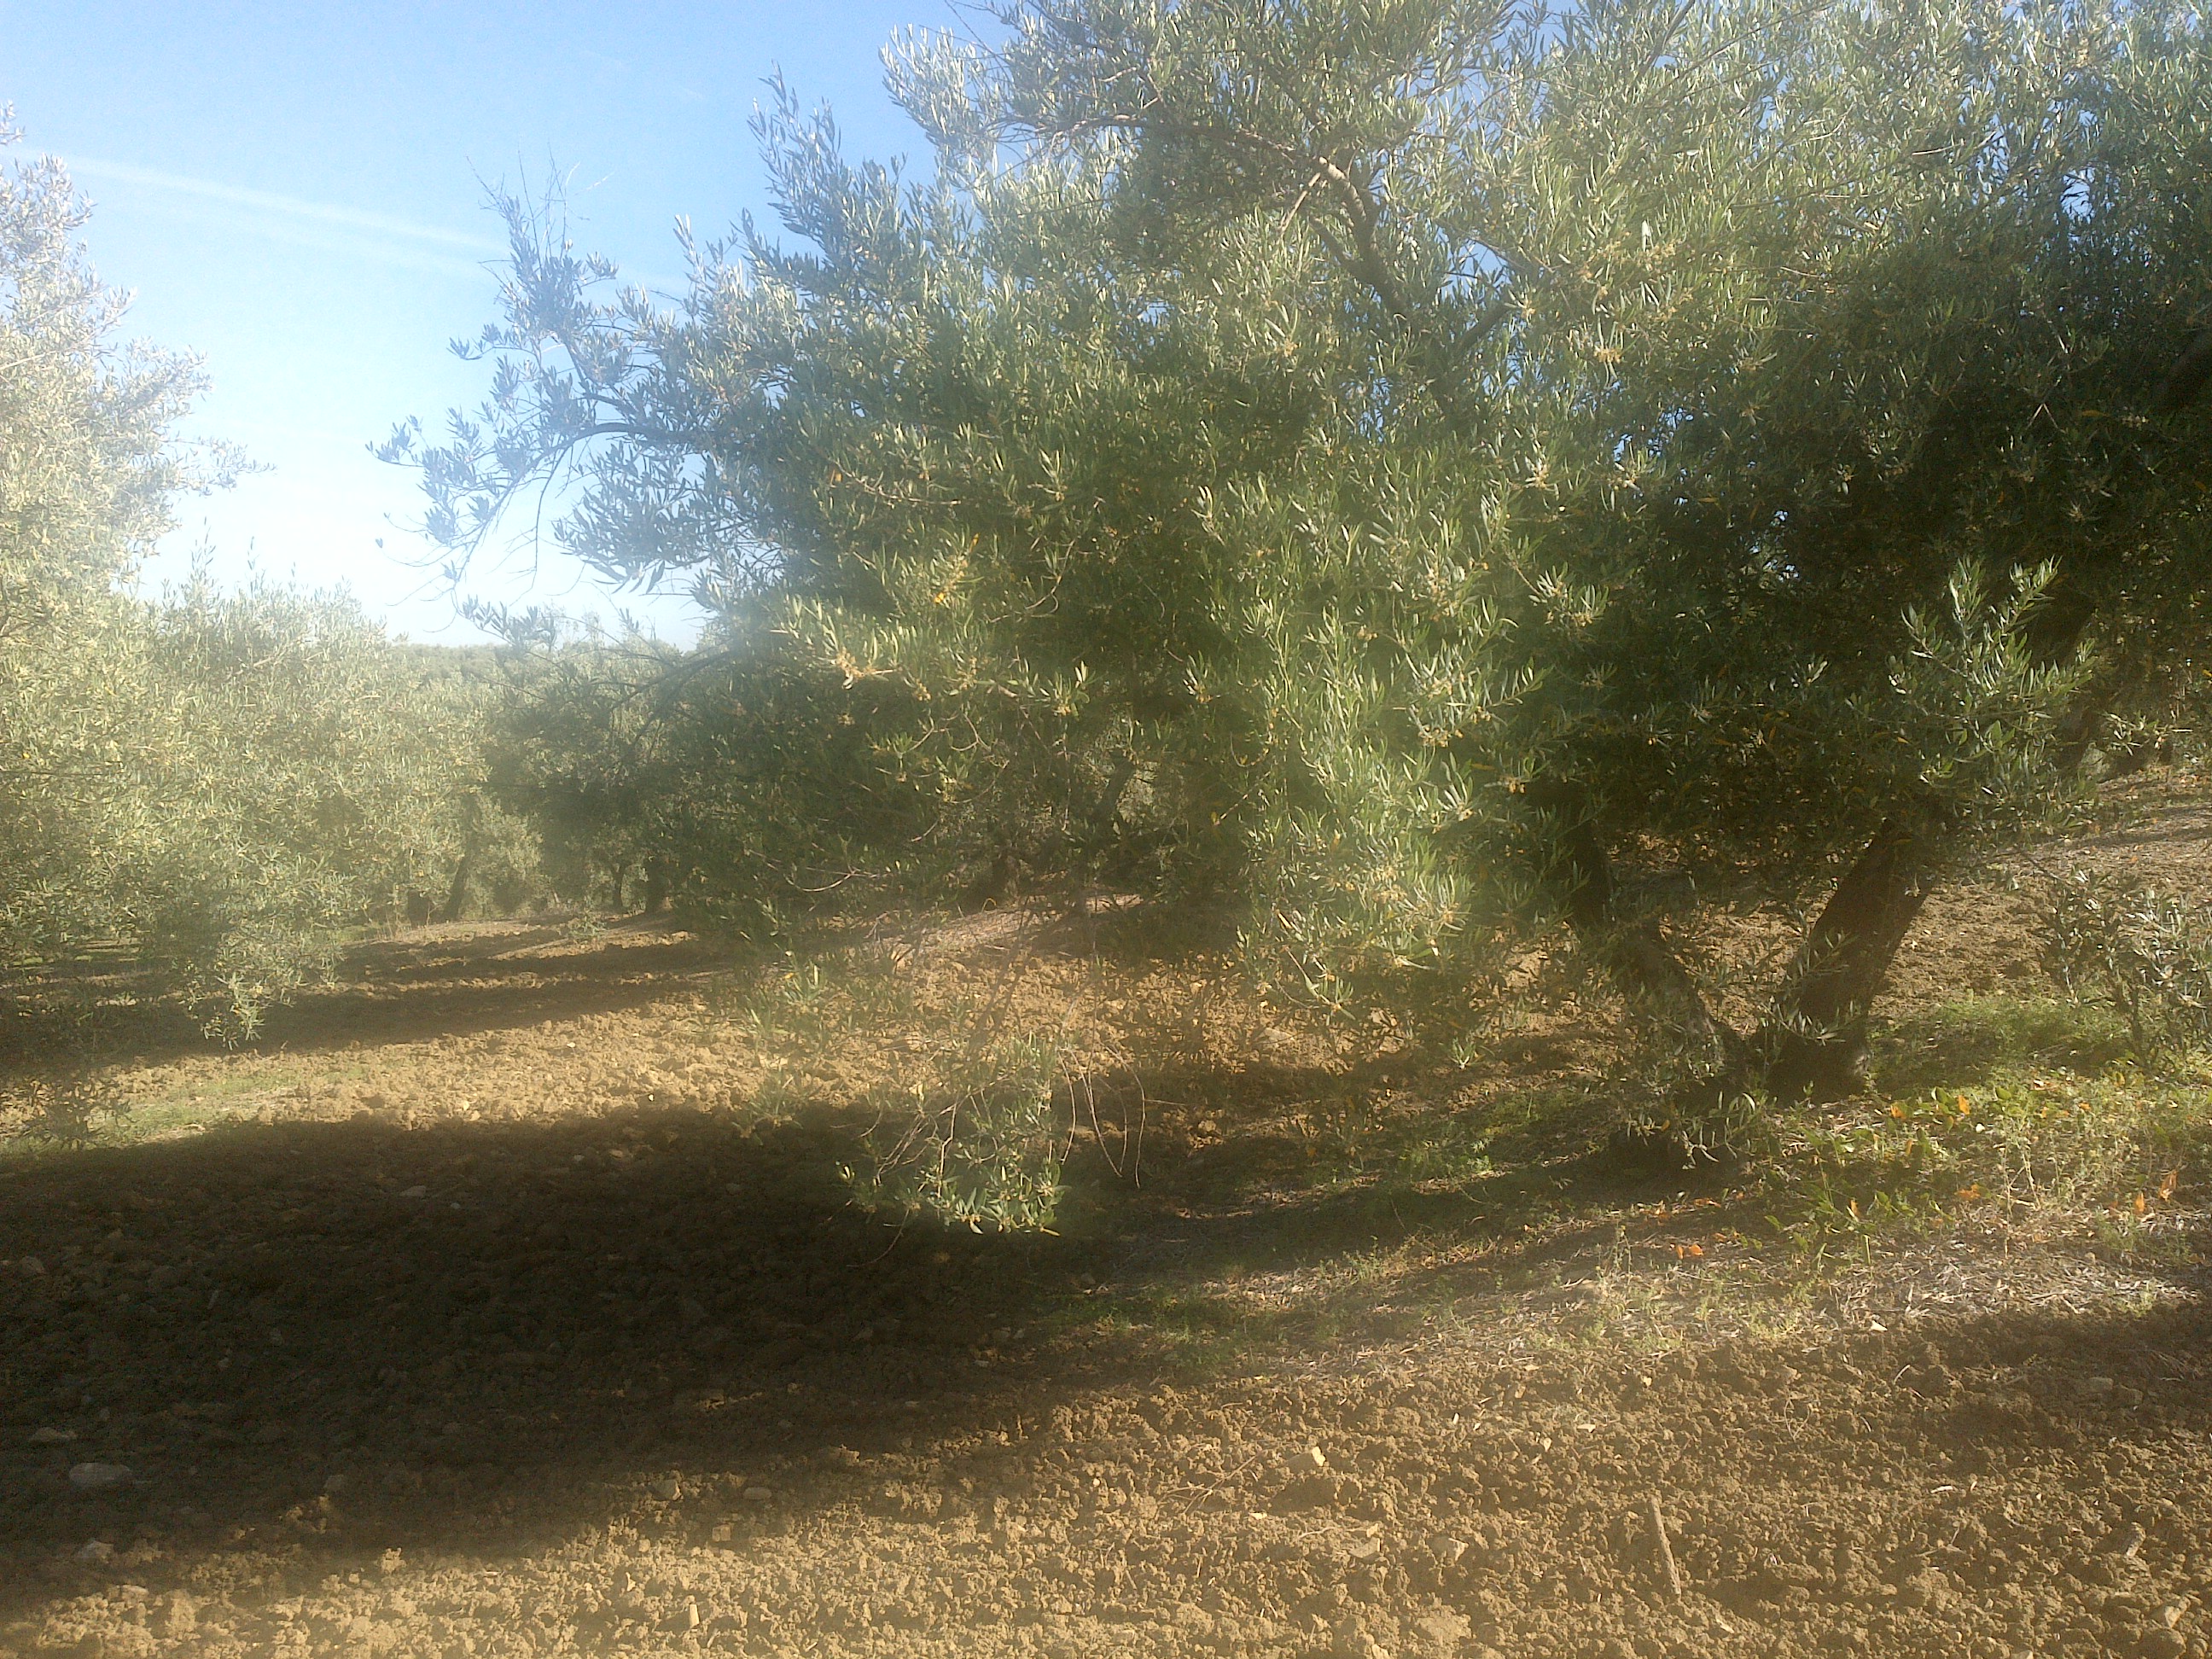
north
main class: Cropland
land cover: Olive groves
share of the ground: 50 - 75 %
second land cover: Other bare soil
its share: > 75 %
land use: Agriculture (excluding fallow land and kitchen gardens)
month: May
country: ES
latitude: 37.6874
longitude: -4.5573
